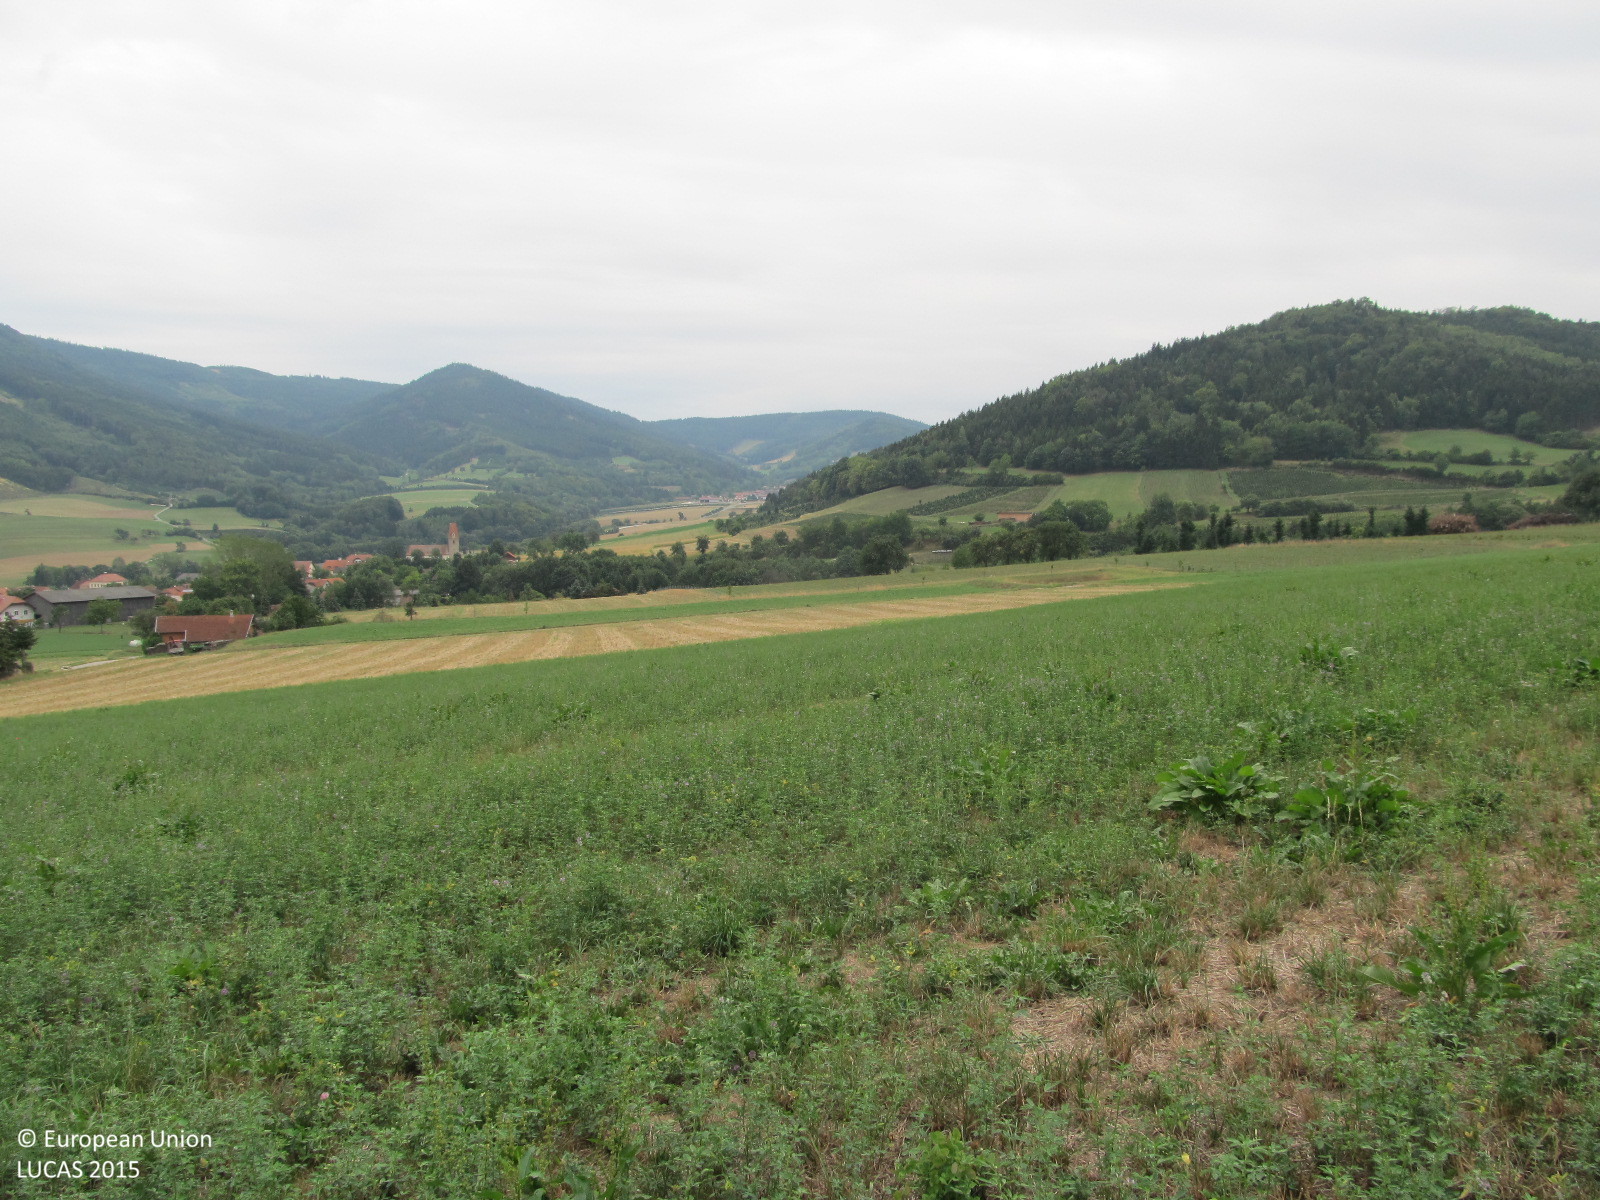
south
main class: Woodland
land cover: Spruce dominated coniferous woodland
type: hemiboreal forest and nemoral coniferous forest and mixed broadleaved-coniferous forest
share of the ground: > 75 %
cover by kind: coniferous forest trees 85 %, herbaceous plants 15 %
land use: Forestry
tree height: < 5 m
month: September
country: AT
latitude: 48.3663
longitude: 15.3069
